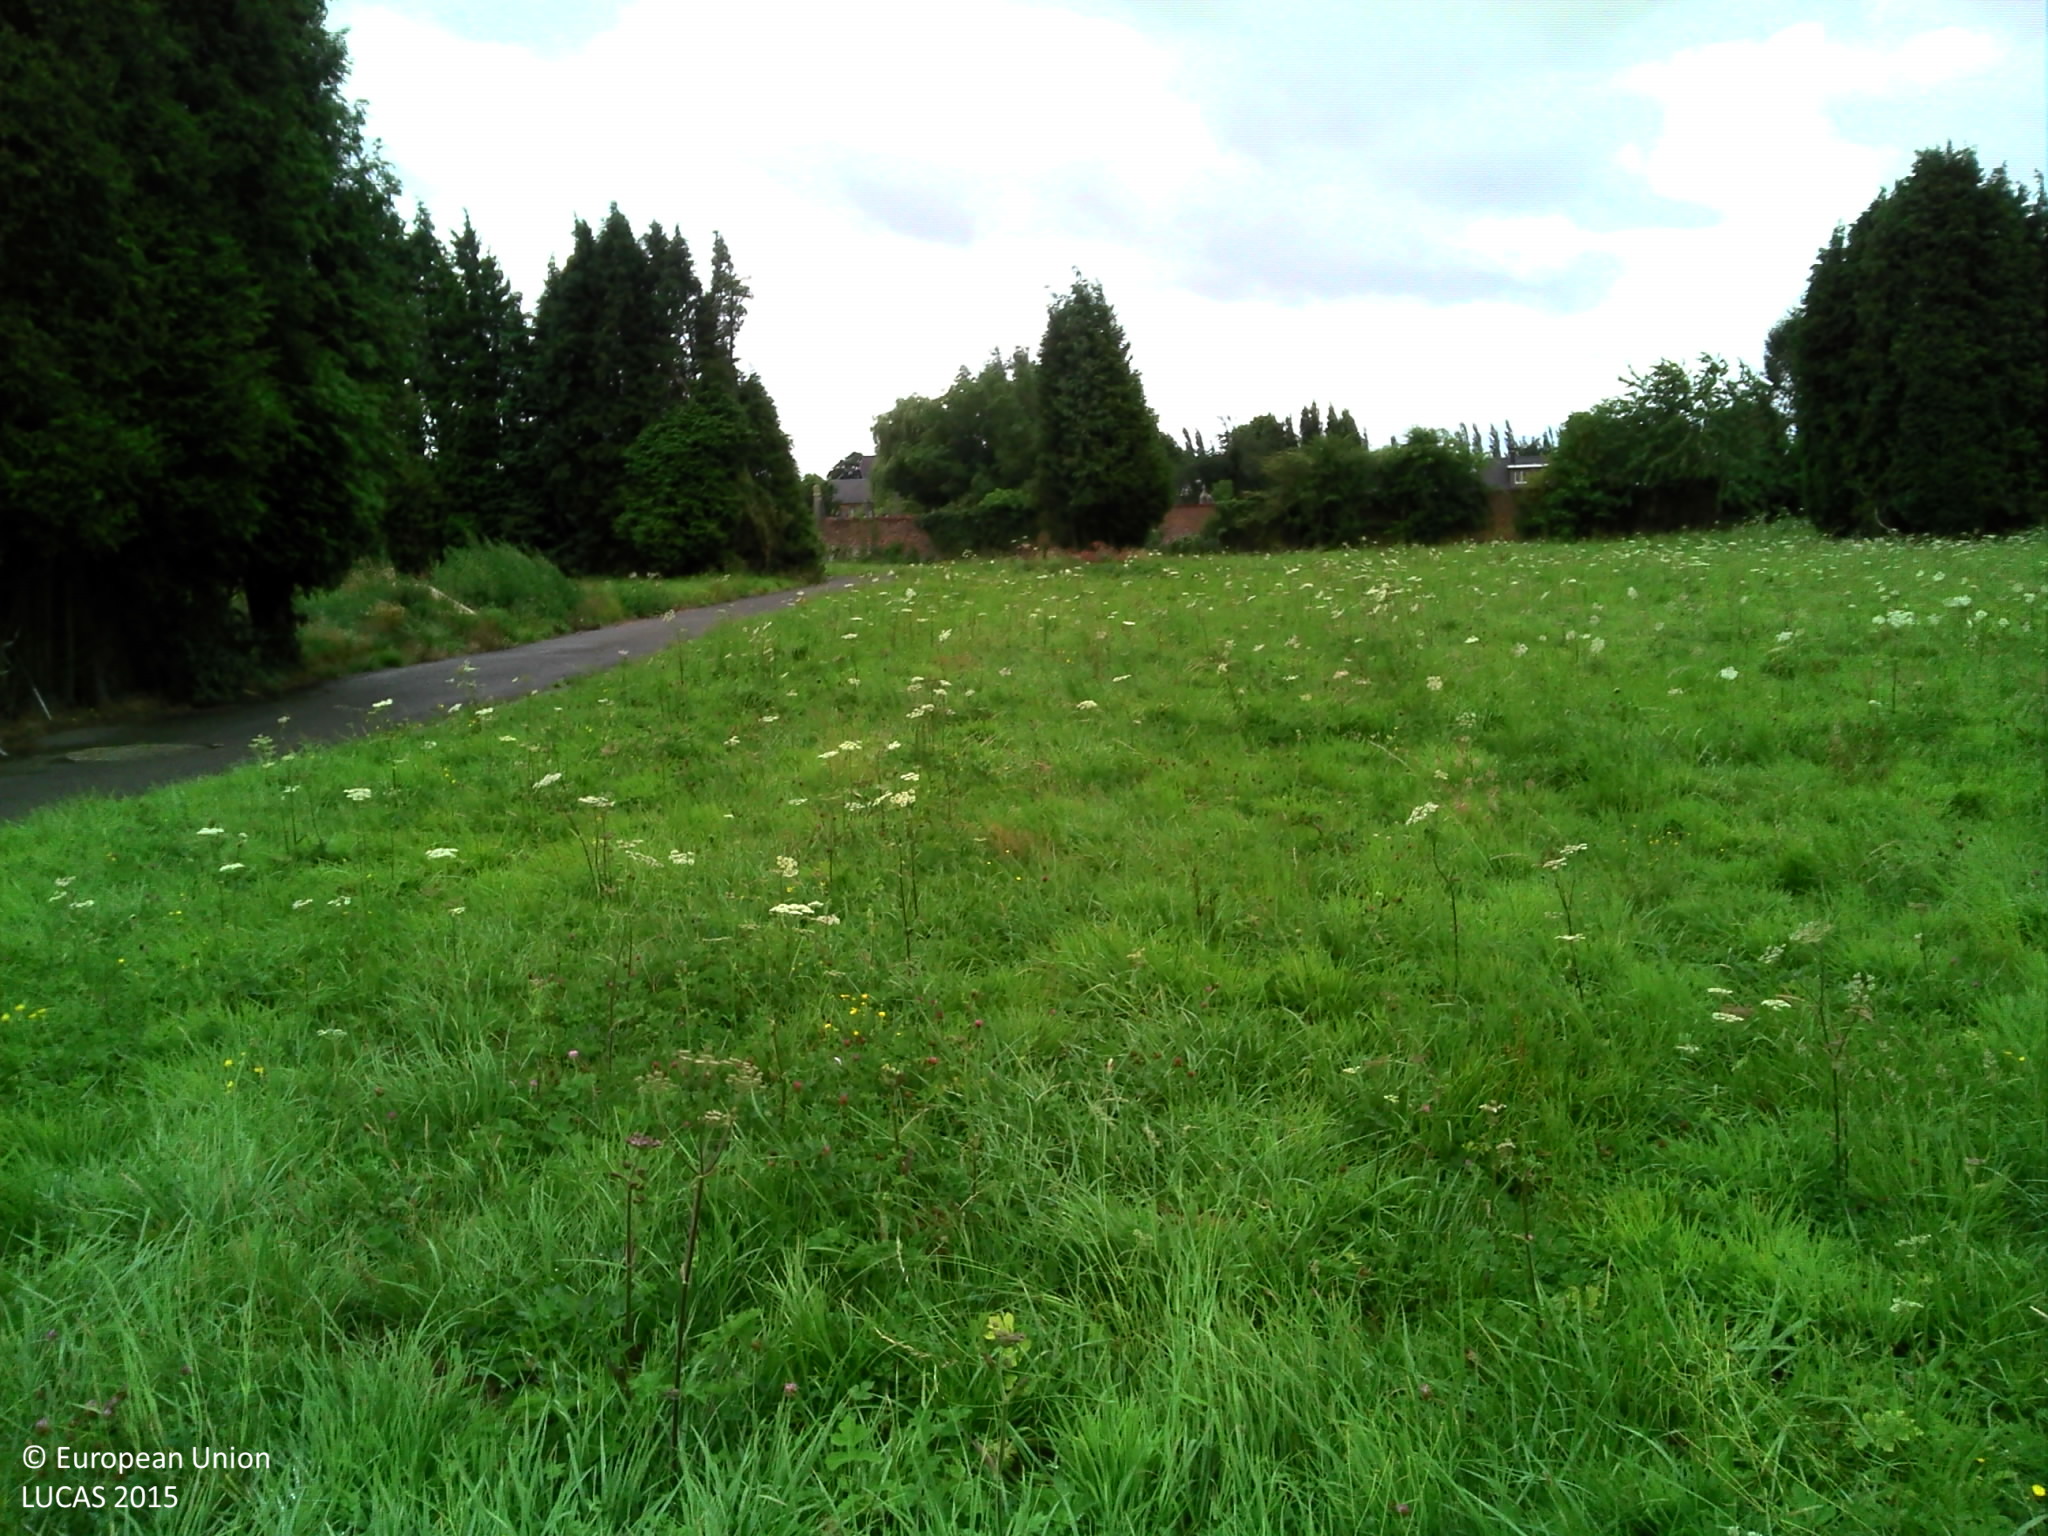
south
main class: Grassland
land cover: Grassland without tree/shrub cover
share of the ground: > 75 %
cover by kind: herbaceous plants 100 %
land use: Community services
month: July
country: BE
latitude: 50.4861
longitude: 4.5415
